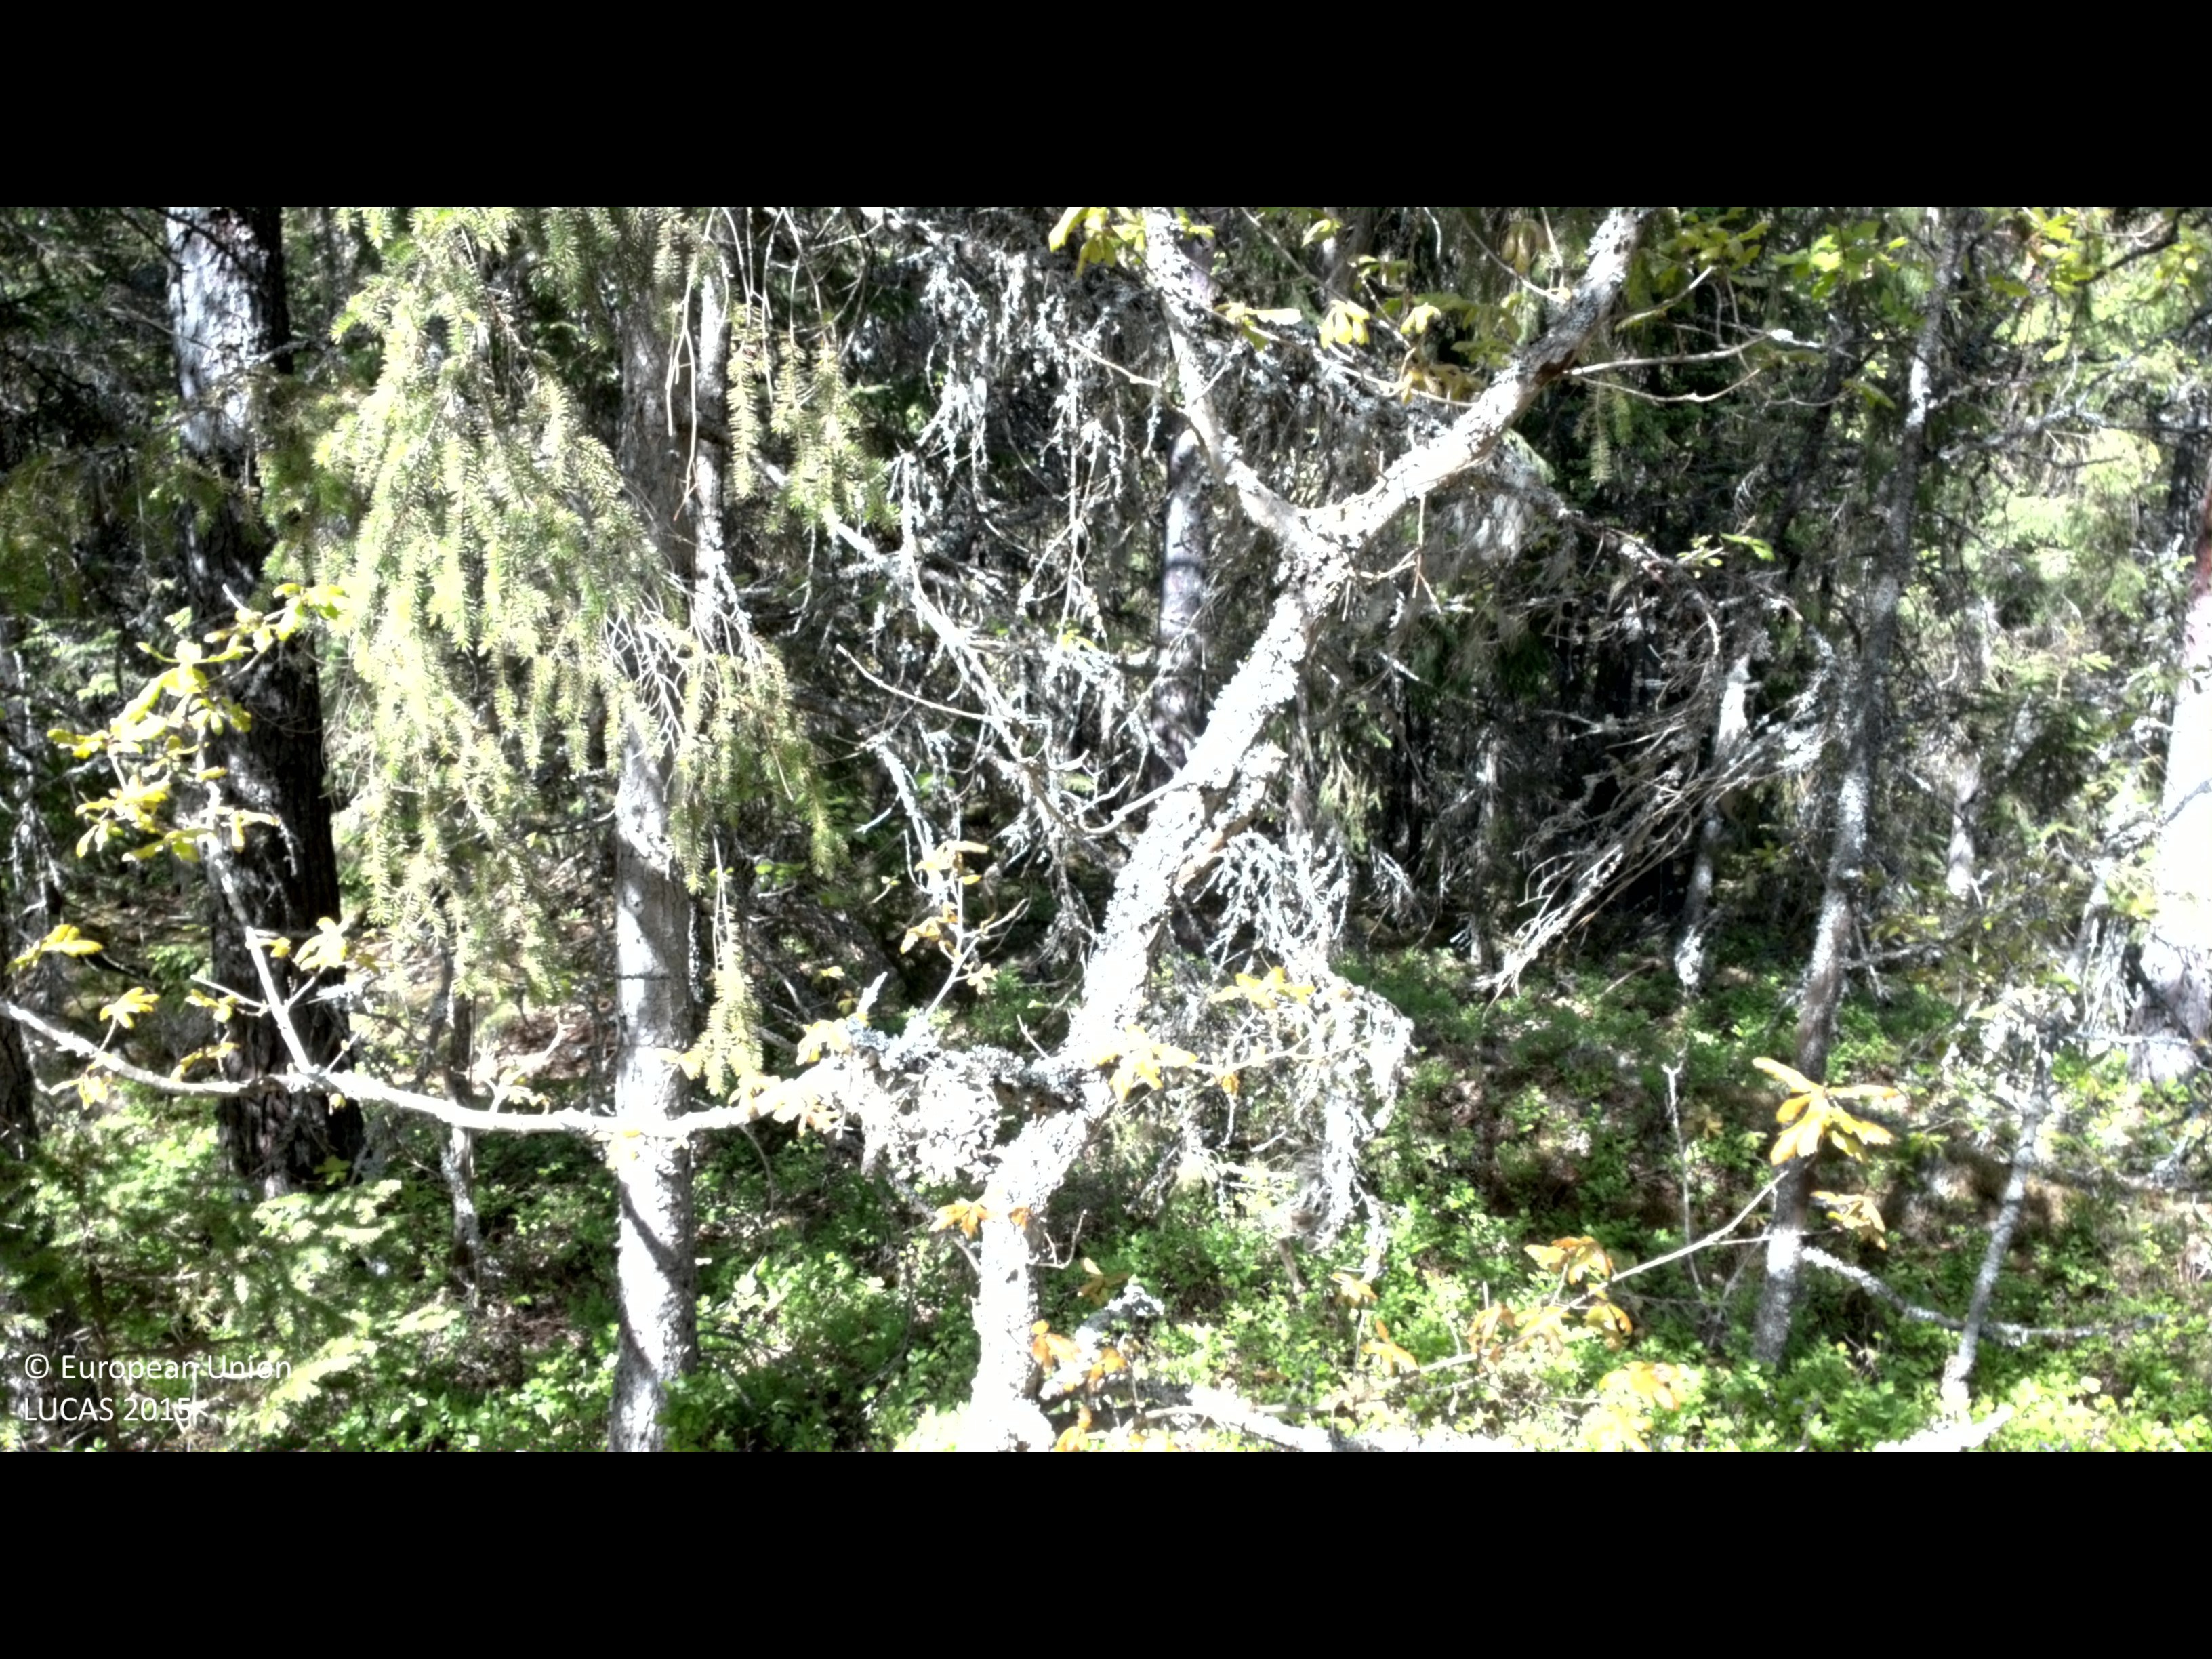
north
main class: Woodland
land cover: Pine dominated coniferous woodland
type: boreal forest
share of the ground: > 75 %
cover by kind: coniferous forest trees 80 %, shrubs 10 %, broadleaved forest trees 5 %, lichens and mosses 5 %
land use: Forestry
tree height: > 5 m
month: May
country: SE
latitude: 57.3026
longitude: 16.1565
